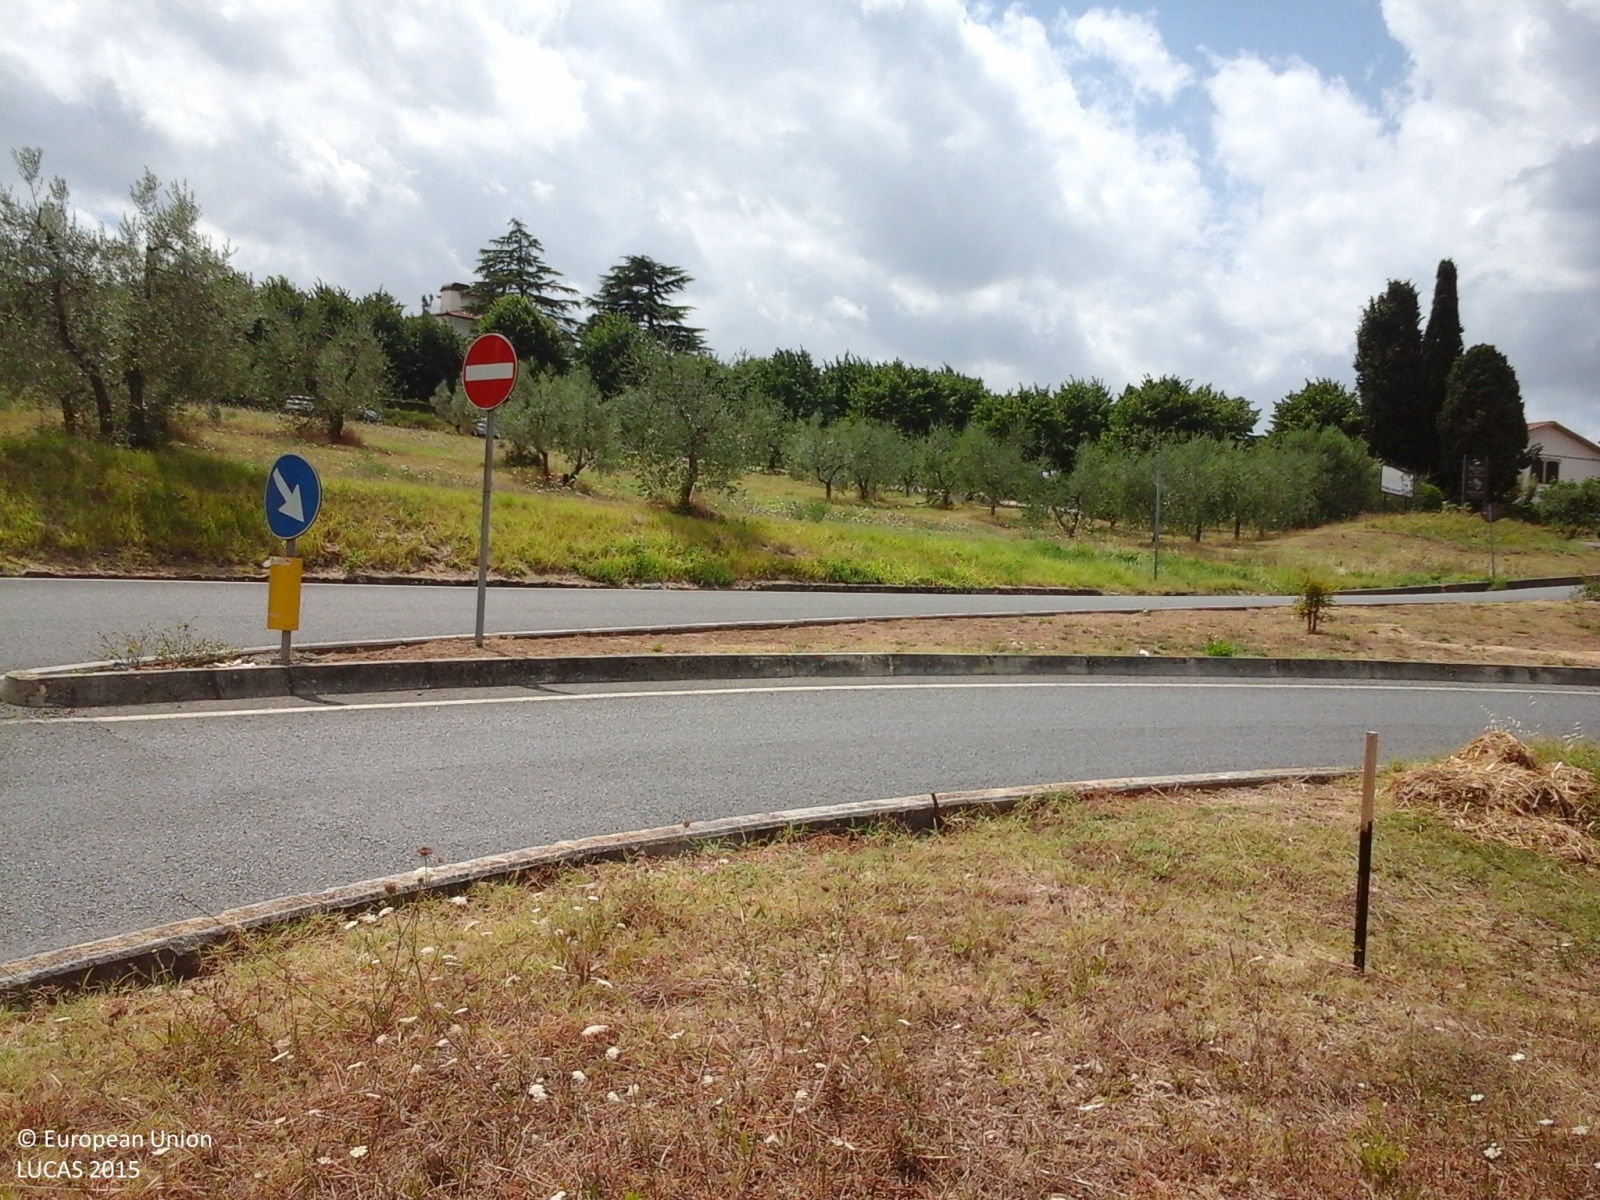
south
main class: Cropland
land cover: Olive groves
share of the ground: > 75 %
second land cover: Spontaneously vegetated surfaces
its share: > 75 %
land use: Agriculture (excluding fallow land and kitchen gardens)
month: July
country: IT
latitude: 43.5343
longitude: 10.9502
